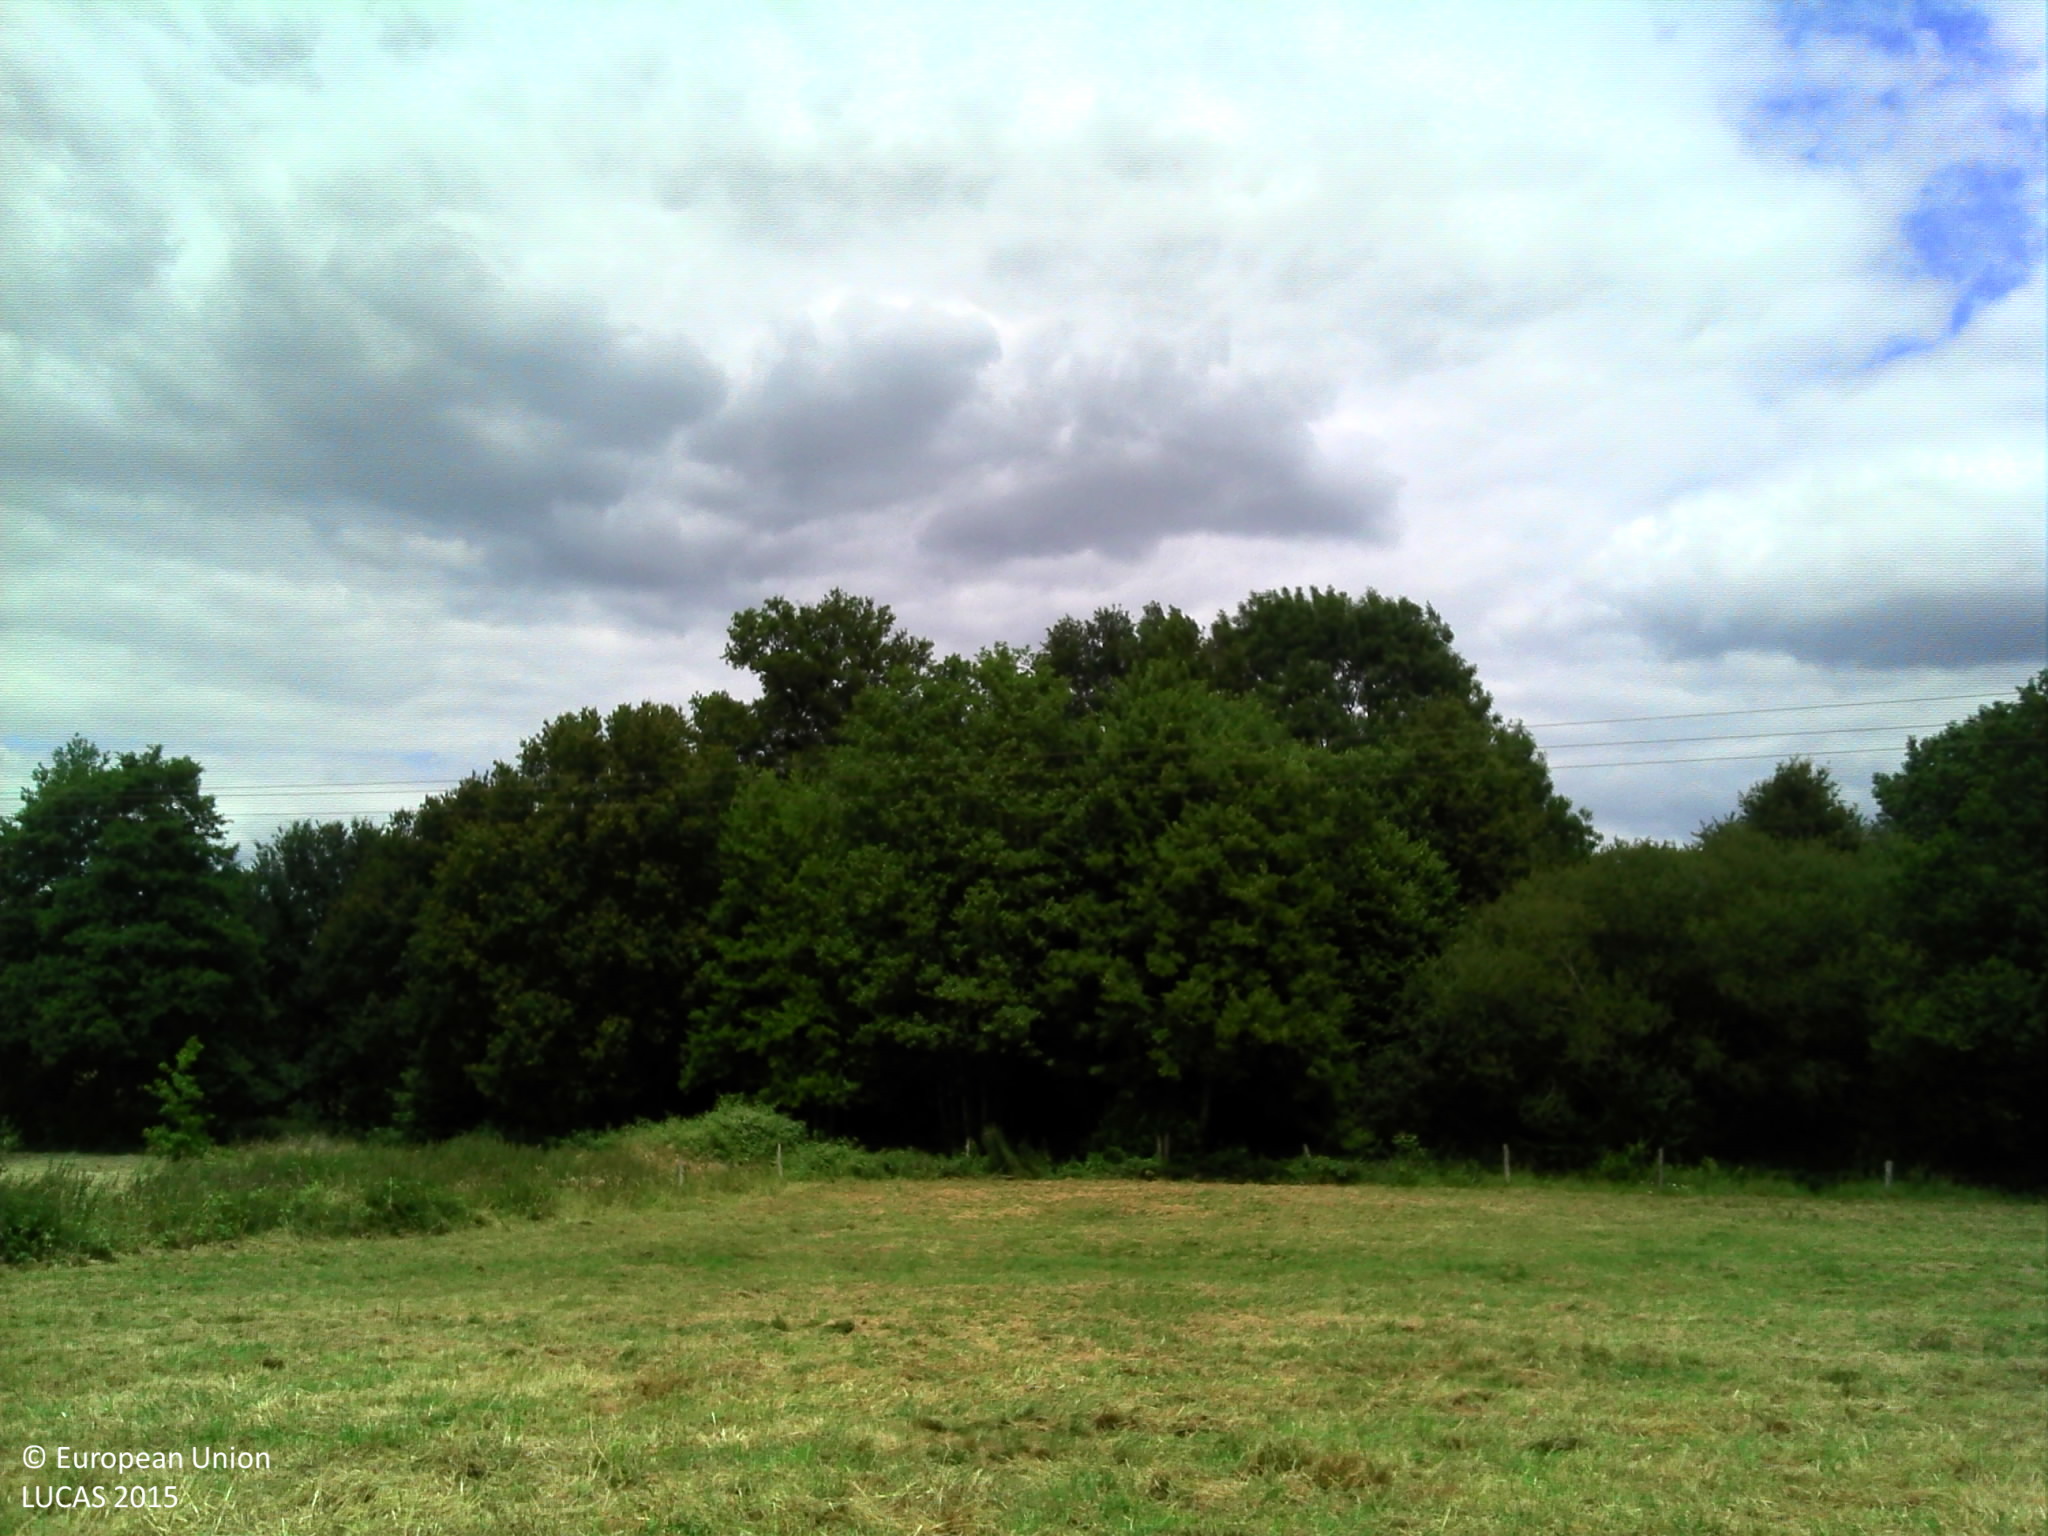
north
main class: Grassland
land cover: Grassland without tree/shrub cover
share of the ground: > 75 %
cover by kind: herbaceous plants 100 %
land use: Agriculture (excluding fallow land and kitchen gardens)
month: June
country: FR
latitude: 47.8682
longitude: 0.3099
